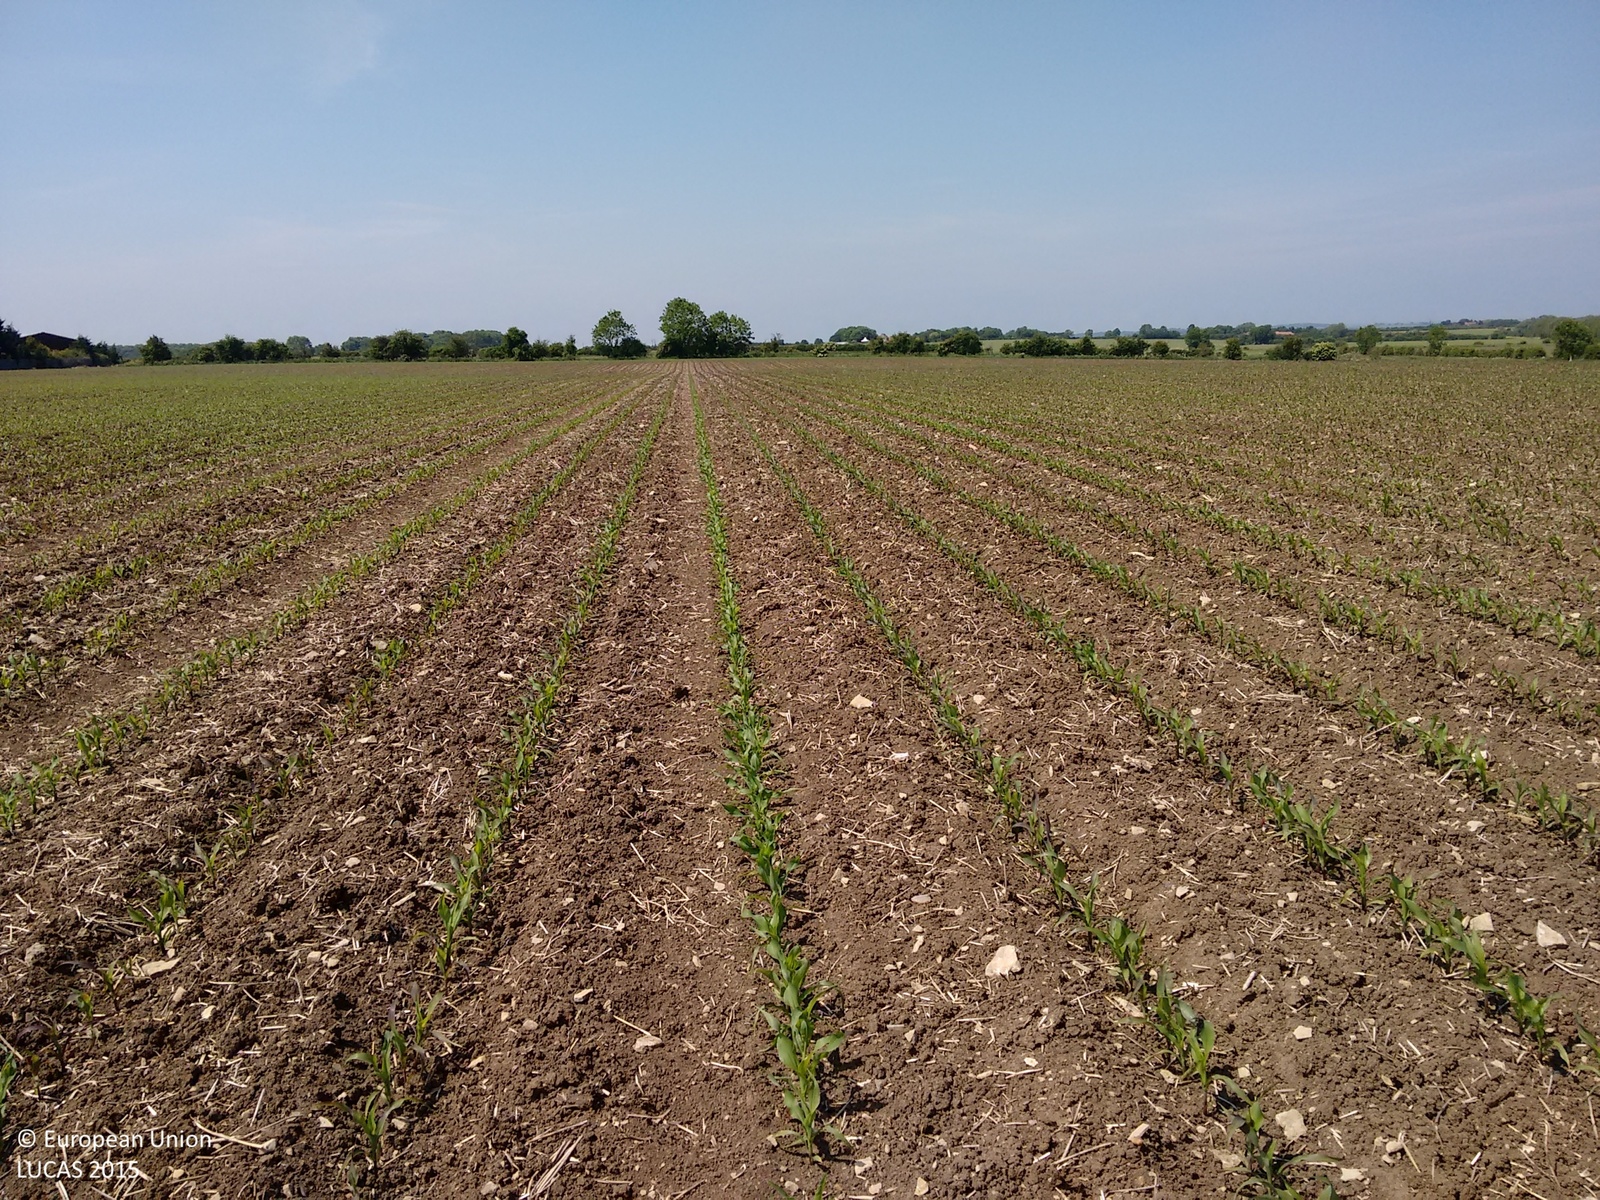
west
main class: Cropland
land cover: Maize
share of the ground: 10 - 25 %
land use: Agriculture (excluding fallow land and kitchen gardens)
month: June
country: GB
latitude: 53.0093
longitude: -0.7868
